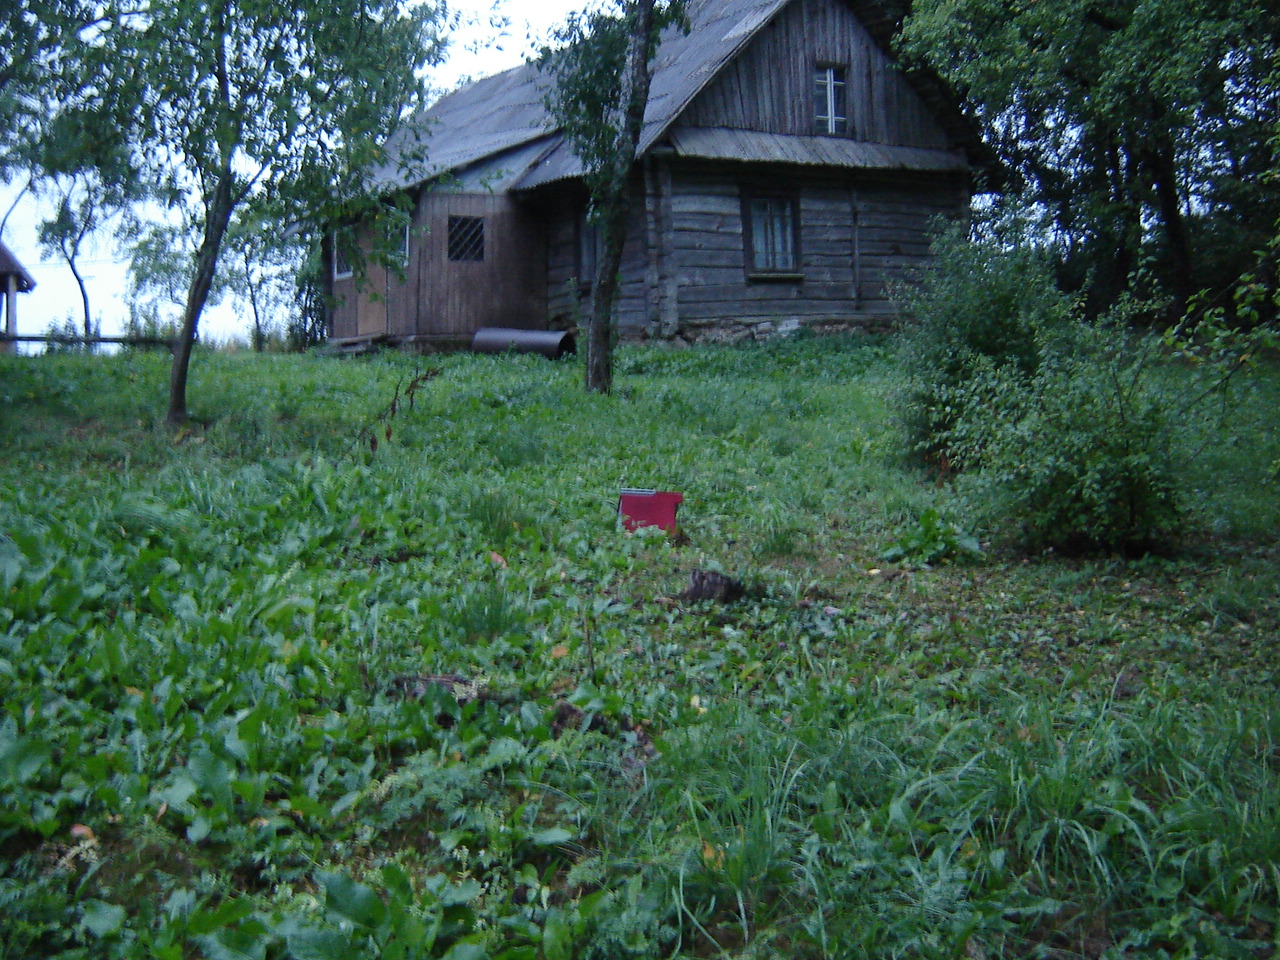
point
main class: Cropland
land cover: Apple fruit
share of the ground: > 75 %
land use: Kitchen garden
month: September
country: LT
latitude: 54.2852
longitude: 24.7482
